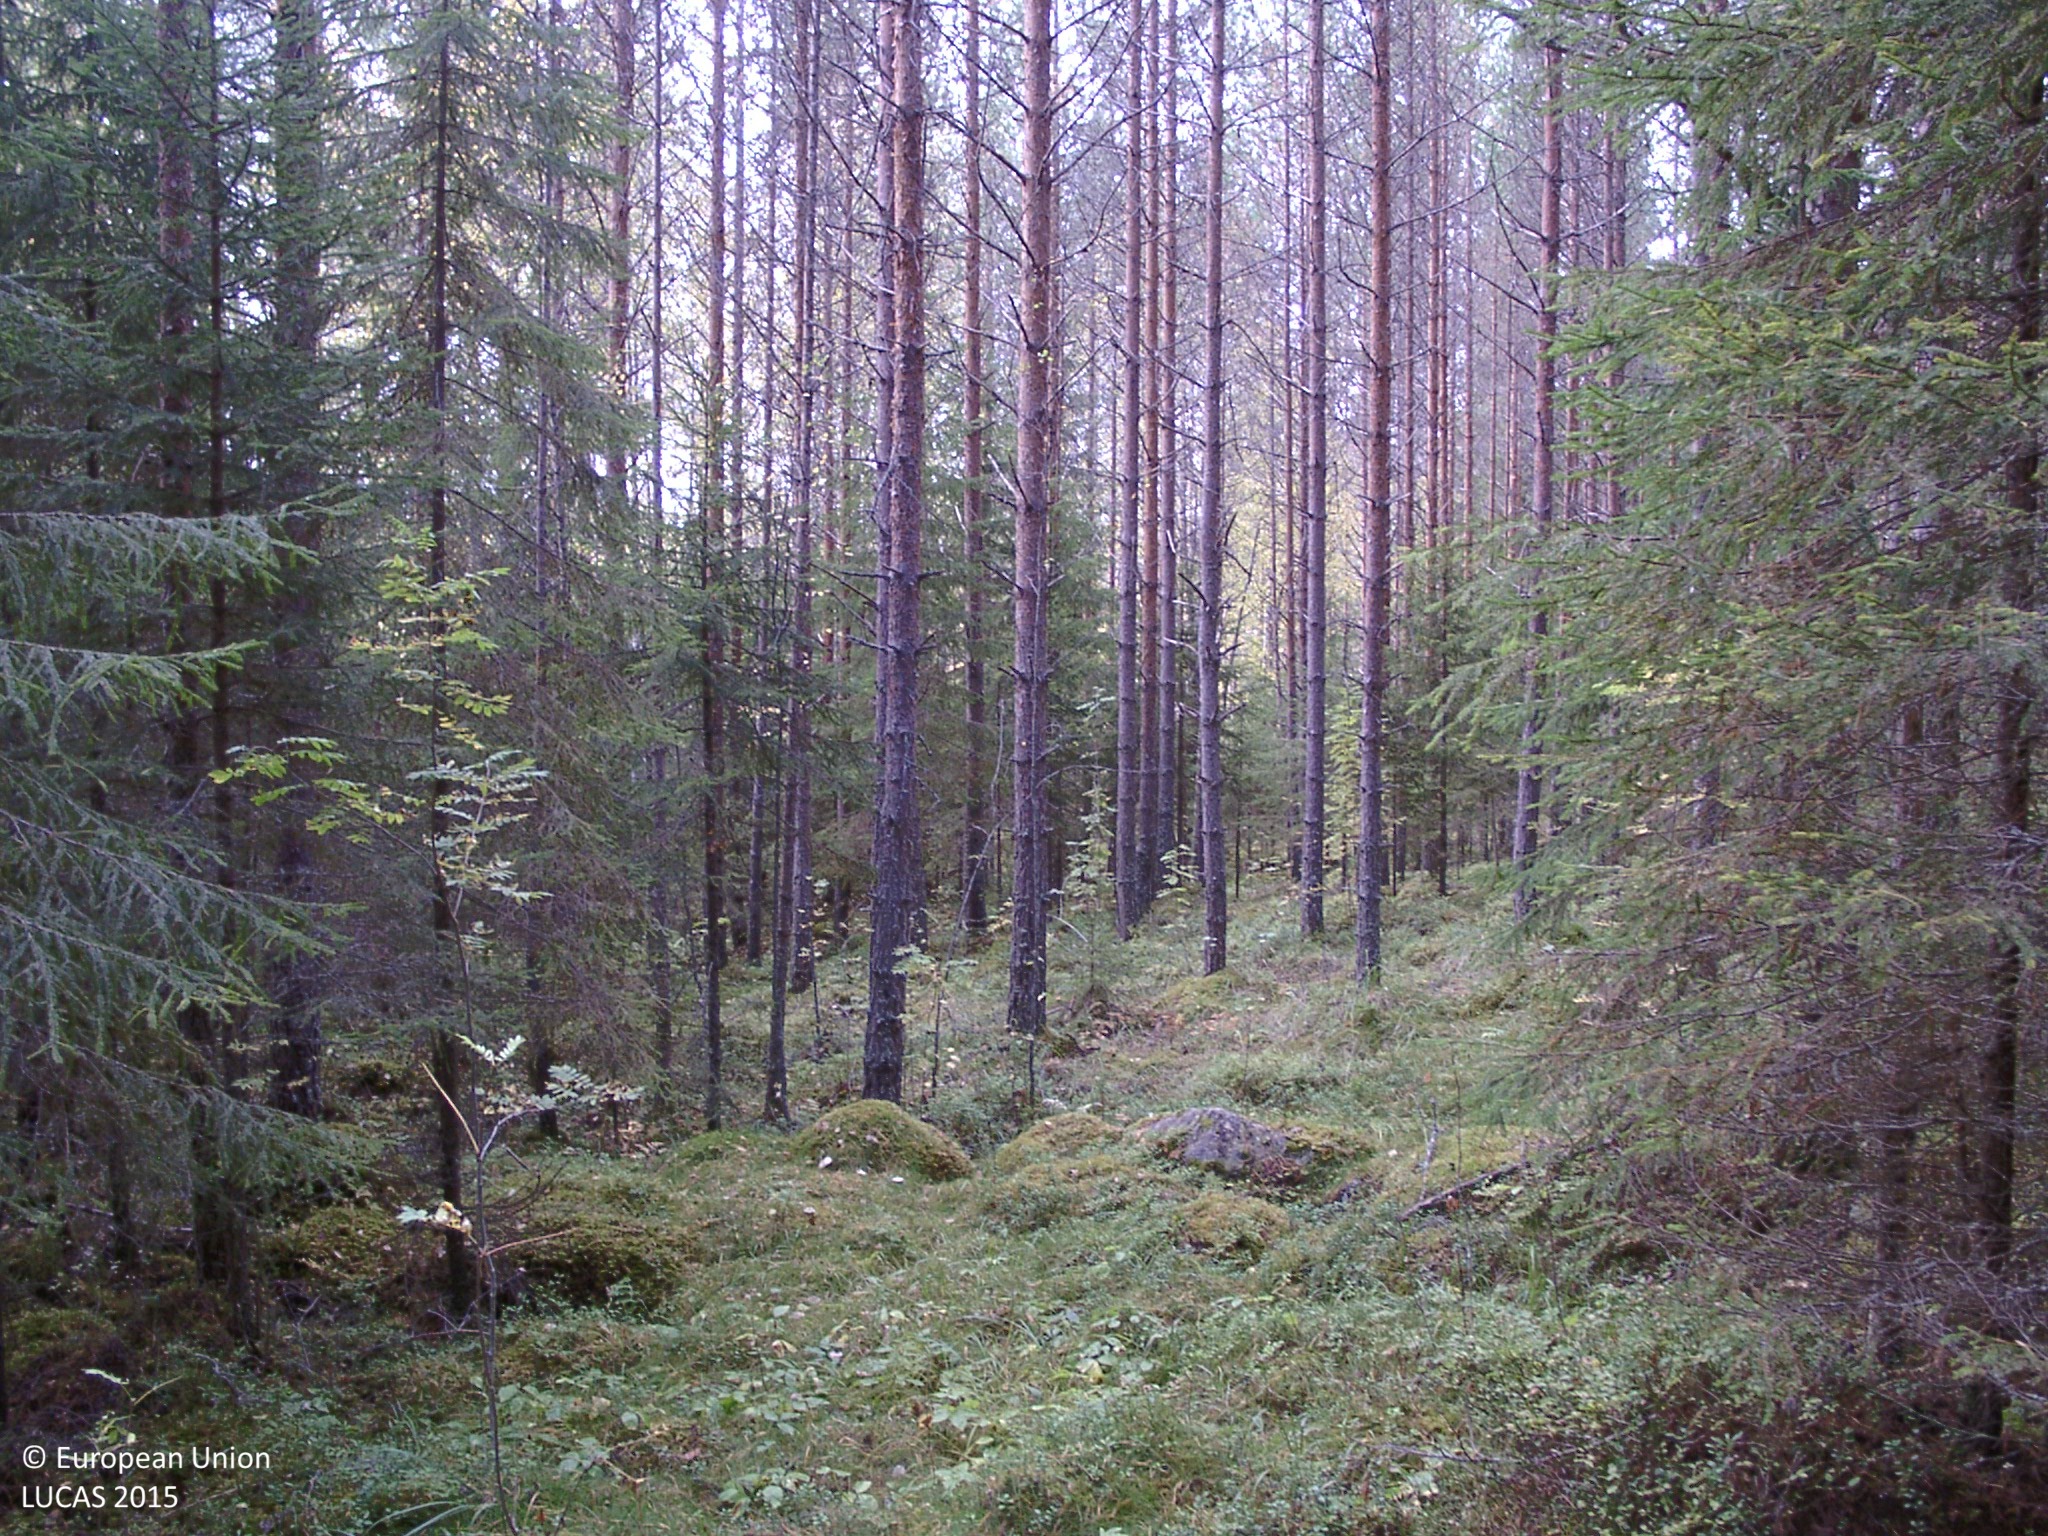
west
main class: Woodland
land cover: Other coniferous woodland
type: boreal forest
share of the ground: > 75 %
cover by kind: coniferous forest trees 80 %, shrubs 10 %, herbaceous plants 5 %, lichens and mosses 5 %
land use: Forestry
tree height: > 5 m
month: September
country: FI
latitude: 62.5611
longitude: 25.2987
